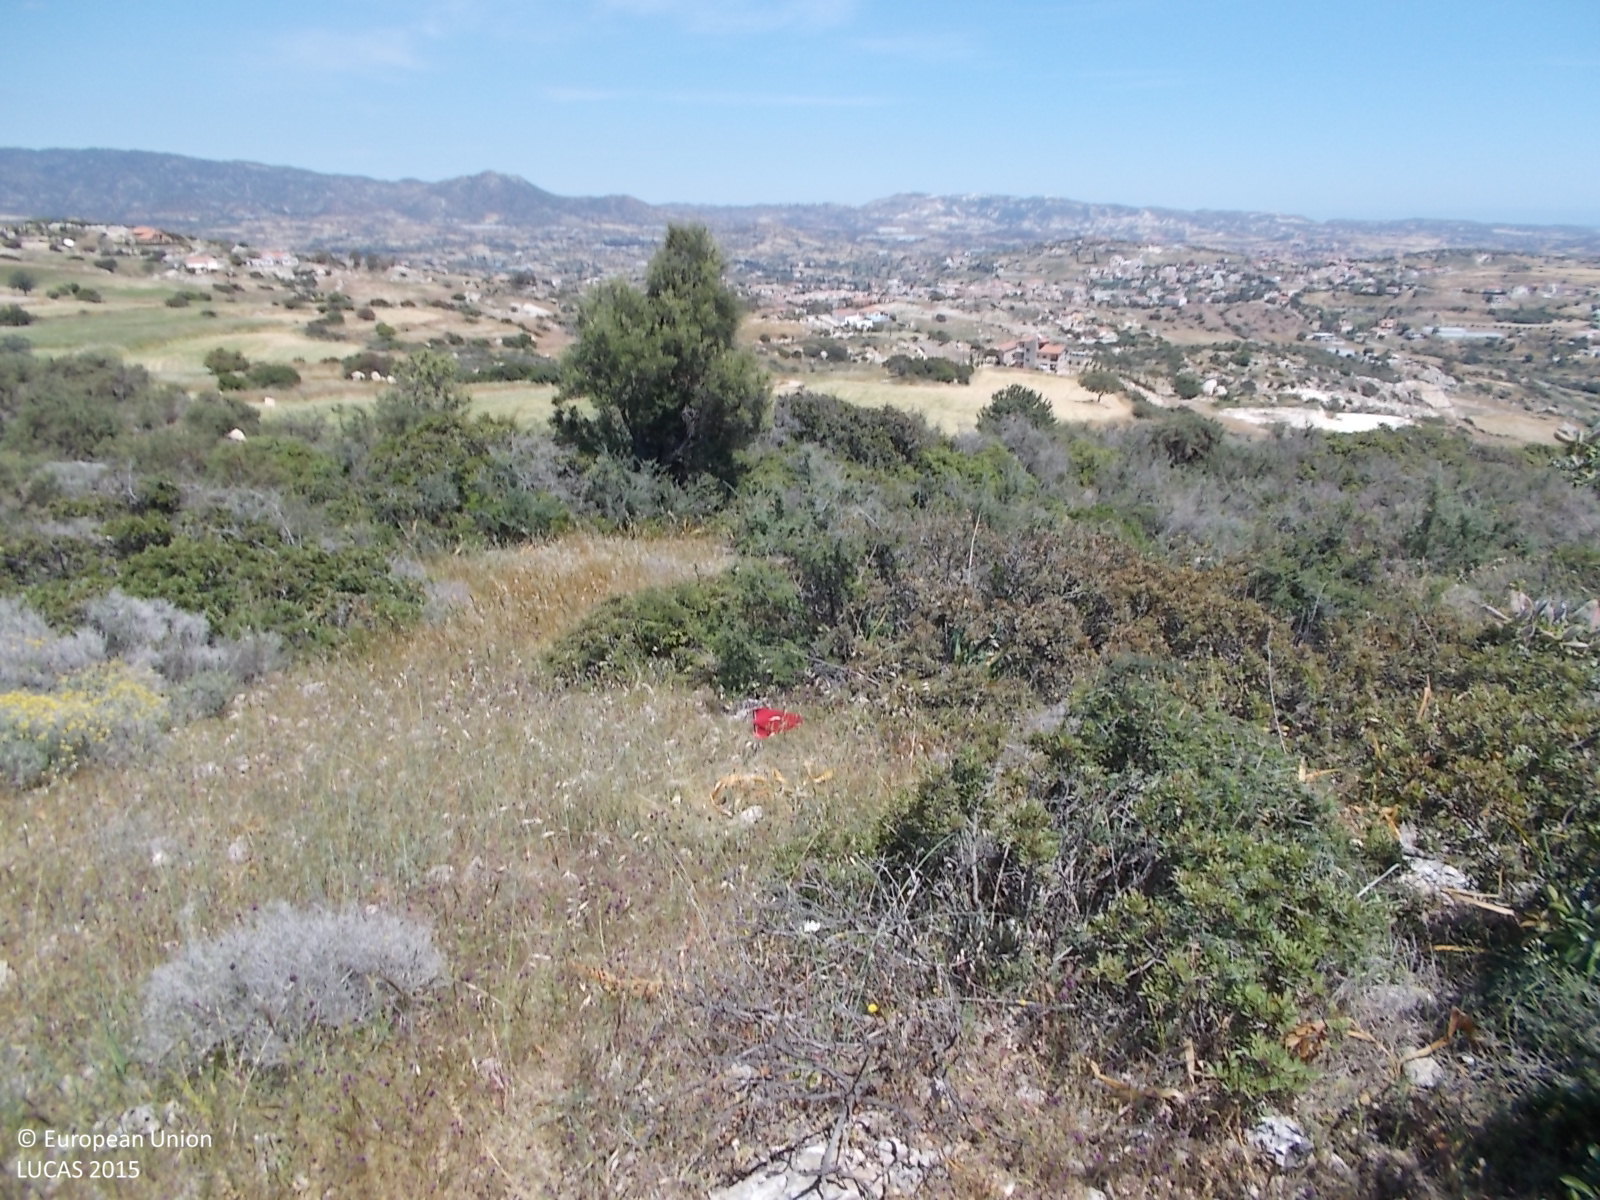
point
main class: Shrubland
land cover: Shrubland with sparse tree cover
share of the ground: > 75 %
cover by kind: shrubs 70 %, herbaceous plants 25 %, broadleaved forest trees 5 %
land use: Semi-natural and natural areas not in use
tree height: < 5 m
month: April
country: CY
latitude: 34.7393
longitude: 33.1400
